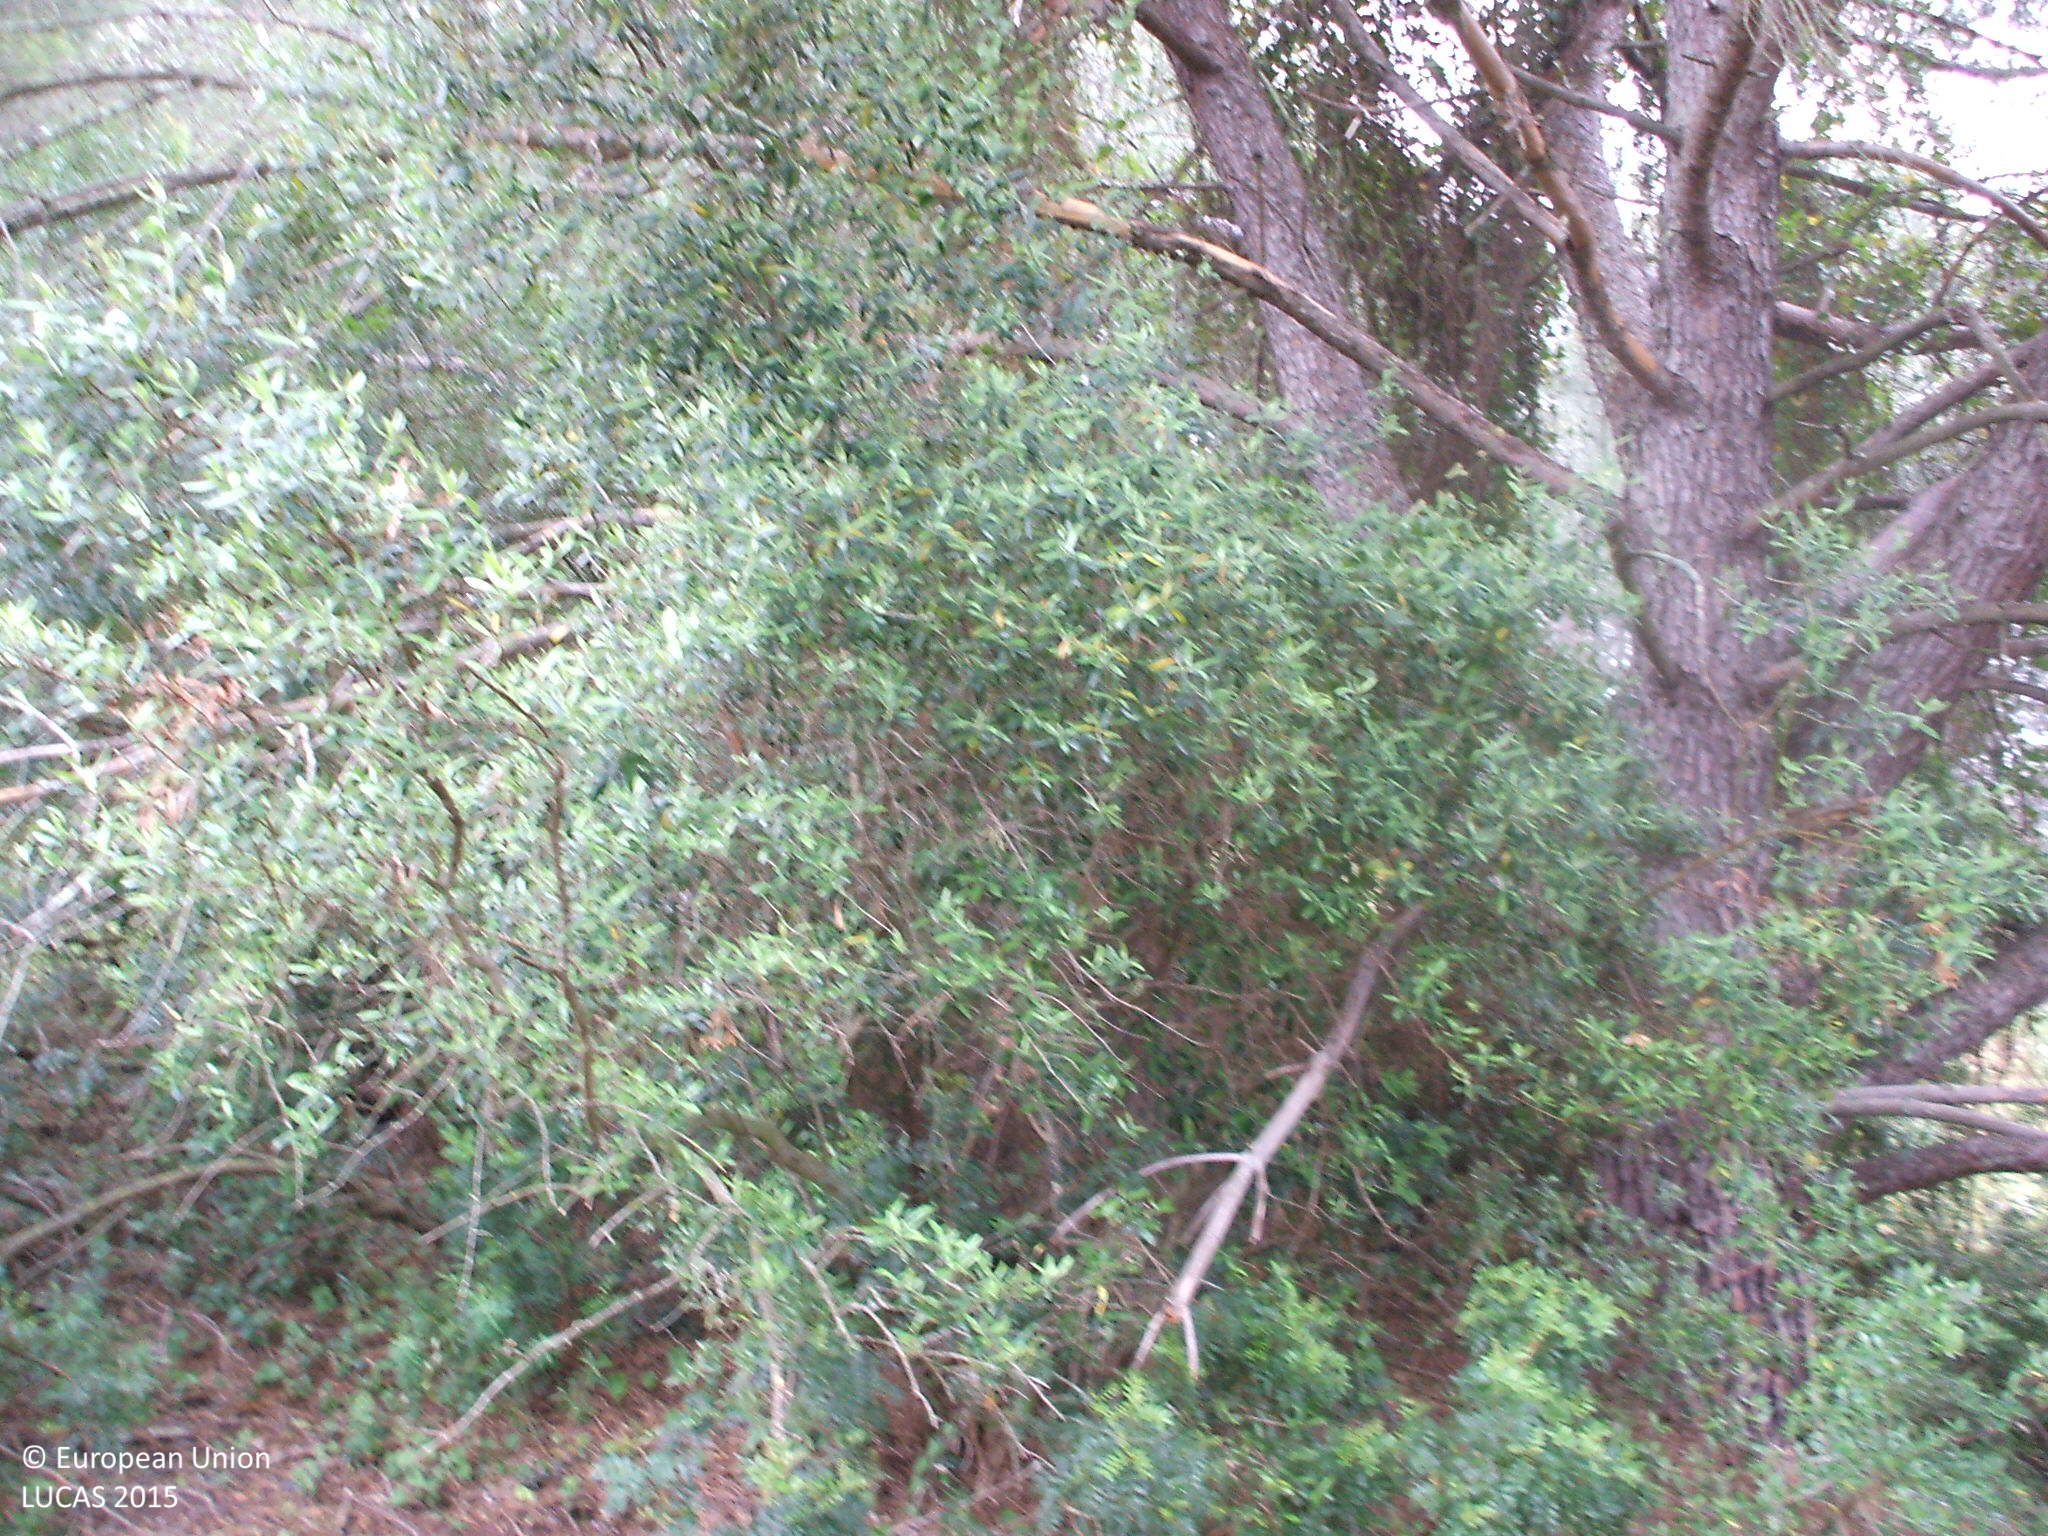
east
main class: Woodland
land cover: Pine dominated coniferous woodland
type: coniferous forest of the mediterranean region
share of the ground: 50 - 75 %
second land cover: Shrubland without tree cover
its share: 10 - 25 %
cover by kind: coniferous forest trees 60 %, shrubs 20 %, herbaceous plants 20 %
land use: Forestry
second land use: Agriculture (excluding fallow land and kitchen gardens)
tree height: > 5 m
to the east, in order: Pine dominated coniferous woodland; Shrubland without tree cover; Broadleaved woodland; Grassland with sparse tree/shrub cover; Tracks; Pine dominated coniferous woodland; Shrubland without tree cover
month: April
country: ES
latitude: 37.7085
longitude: -5.5744
